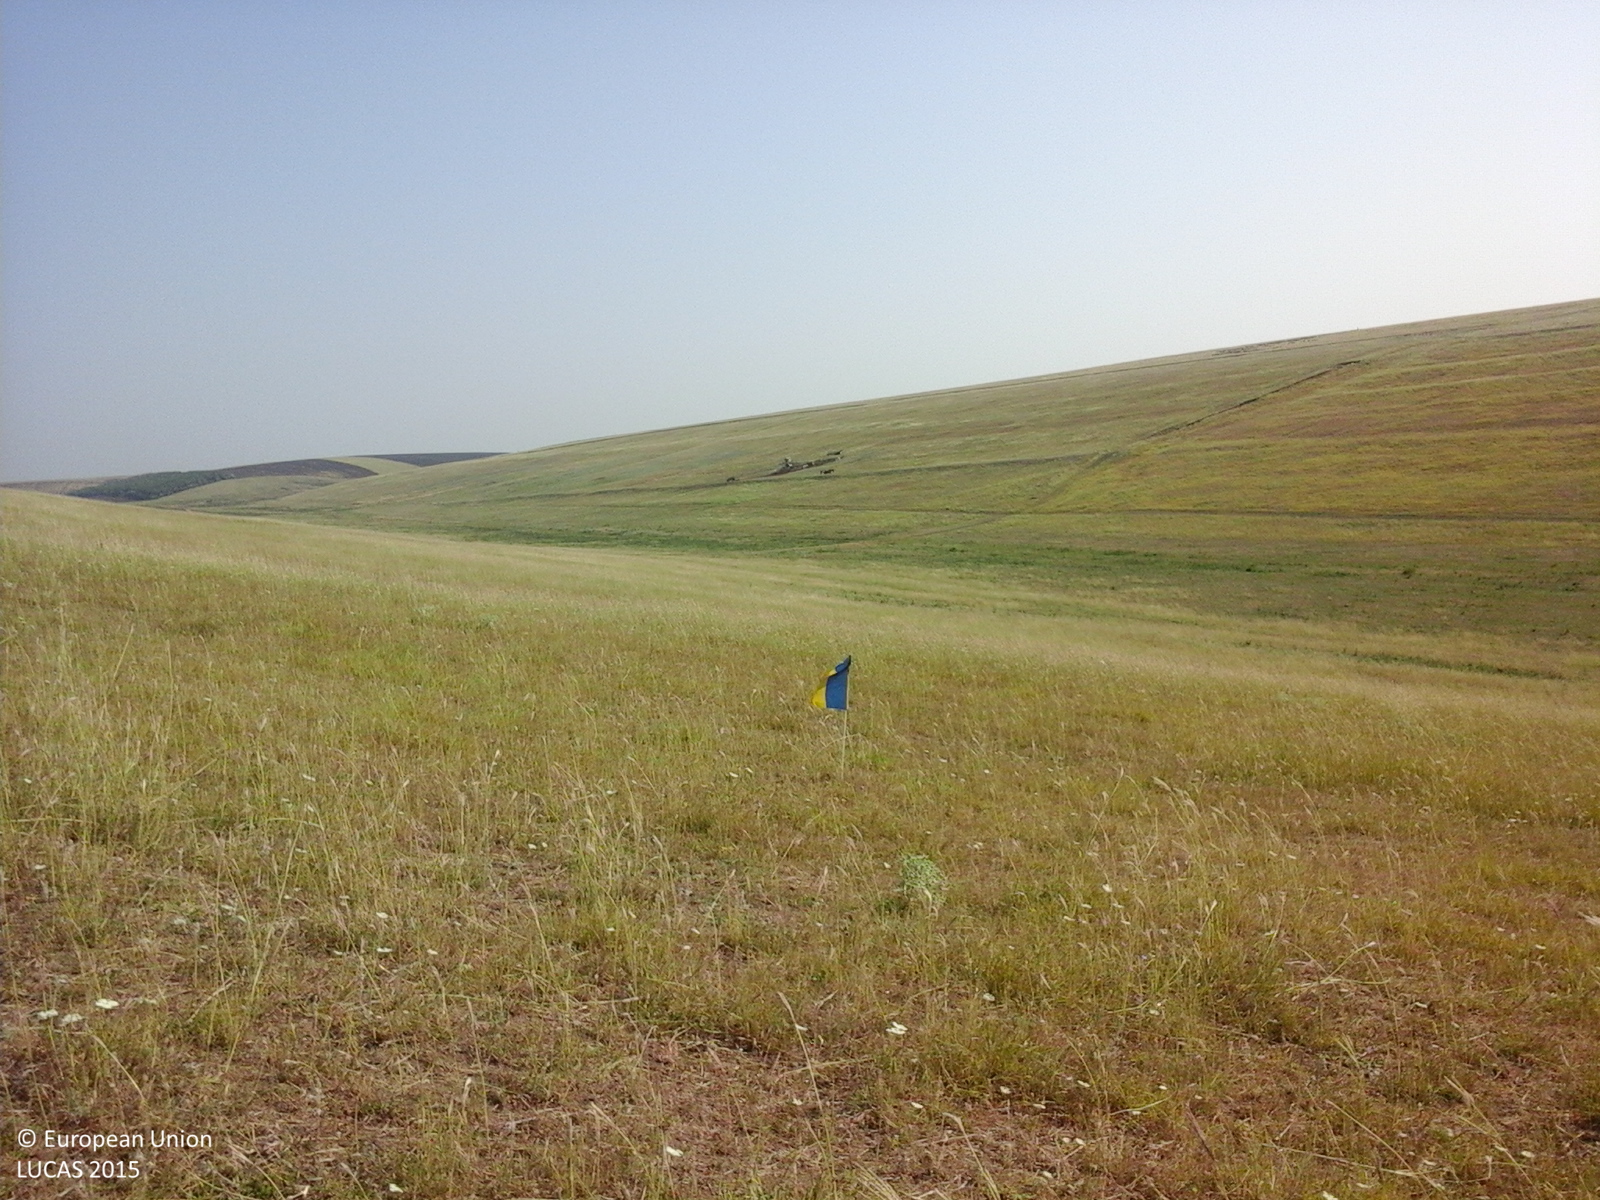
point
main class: Grassland
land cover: Grassland without tree/shrub cover
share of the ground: > 75 %
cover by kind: herbaceous plants 100 %
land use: Agriculture (excluding fallow land and kitchen gardens)
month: July
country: RO
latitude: 45.6522
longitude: 27.9147
